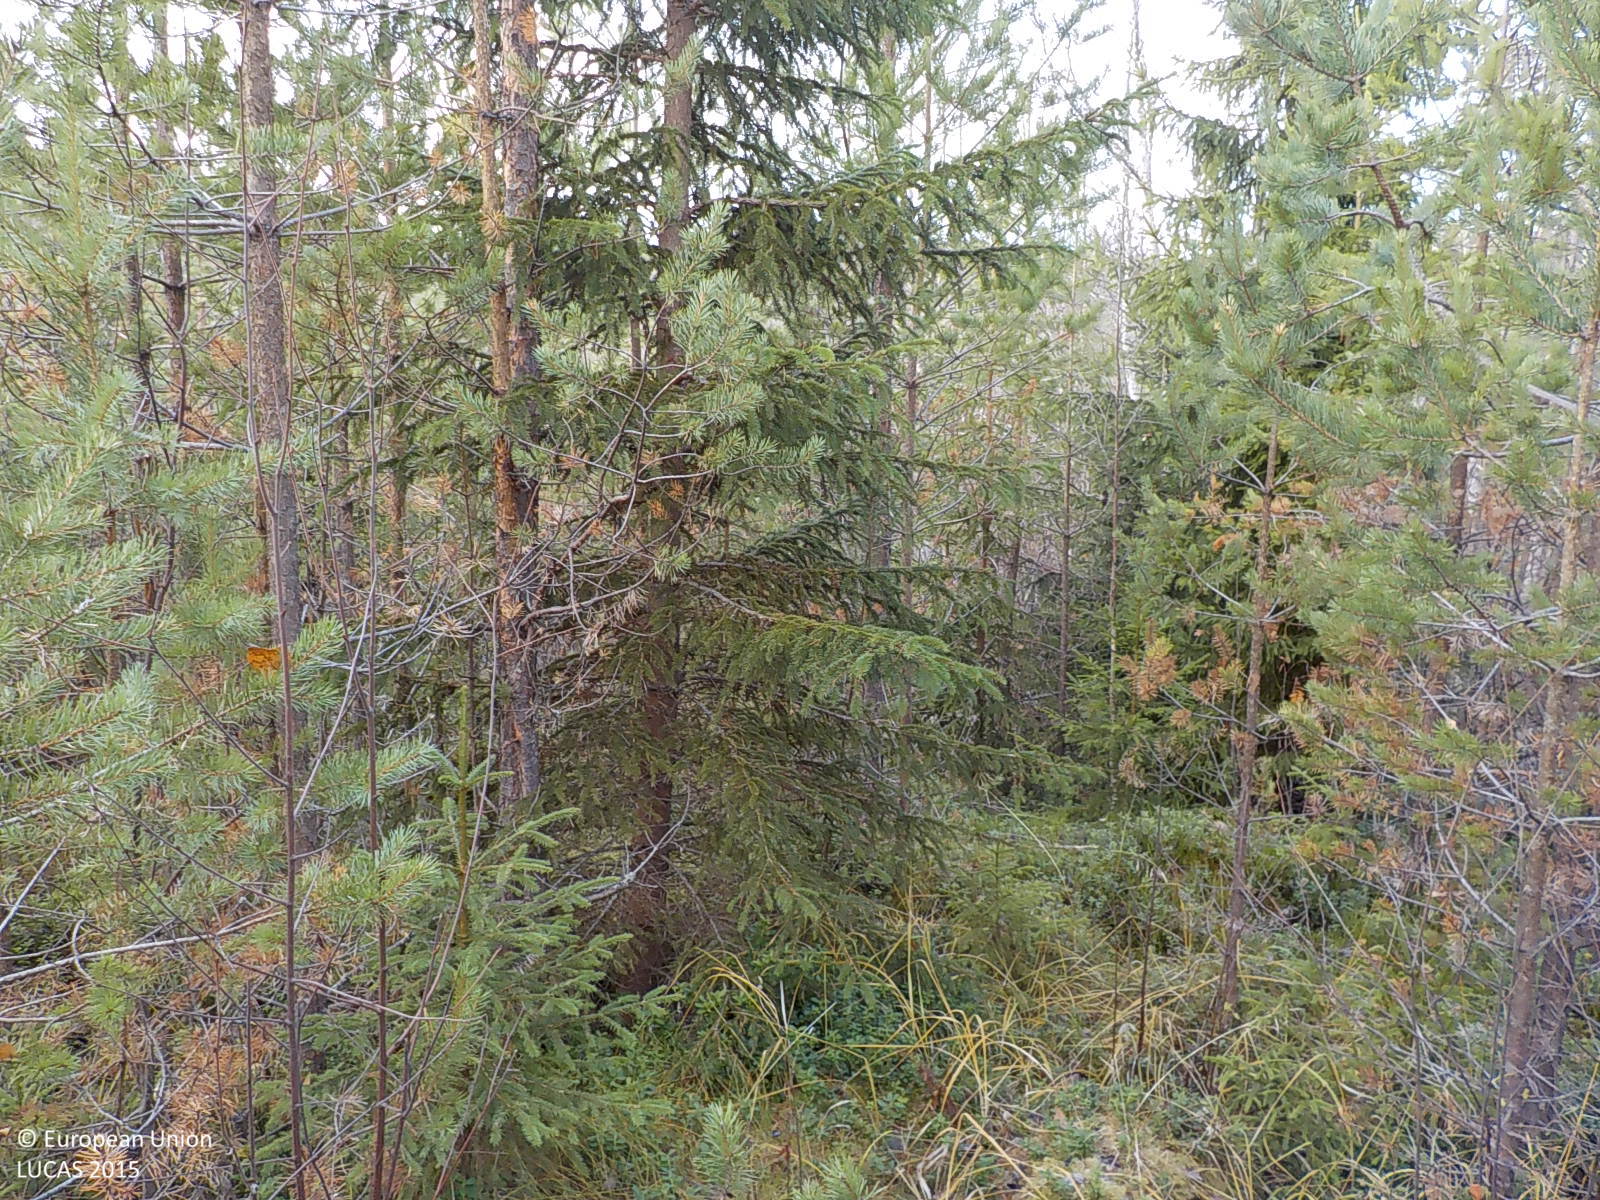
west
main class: Woodland
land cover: Pine dominated coniferous woodland
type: boreal forest
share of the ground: > 75 %
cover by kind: coniferous forest trees 85 %, shrubs 10 %, herbaceous plants 5 %
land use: Forestry
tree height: > 5 m
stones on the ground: < 10 %
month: October
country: SE
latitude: 63.3379
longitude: 16.9858
